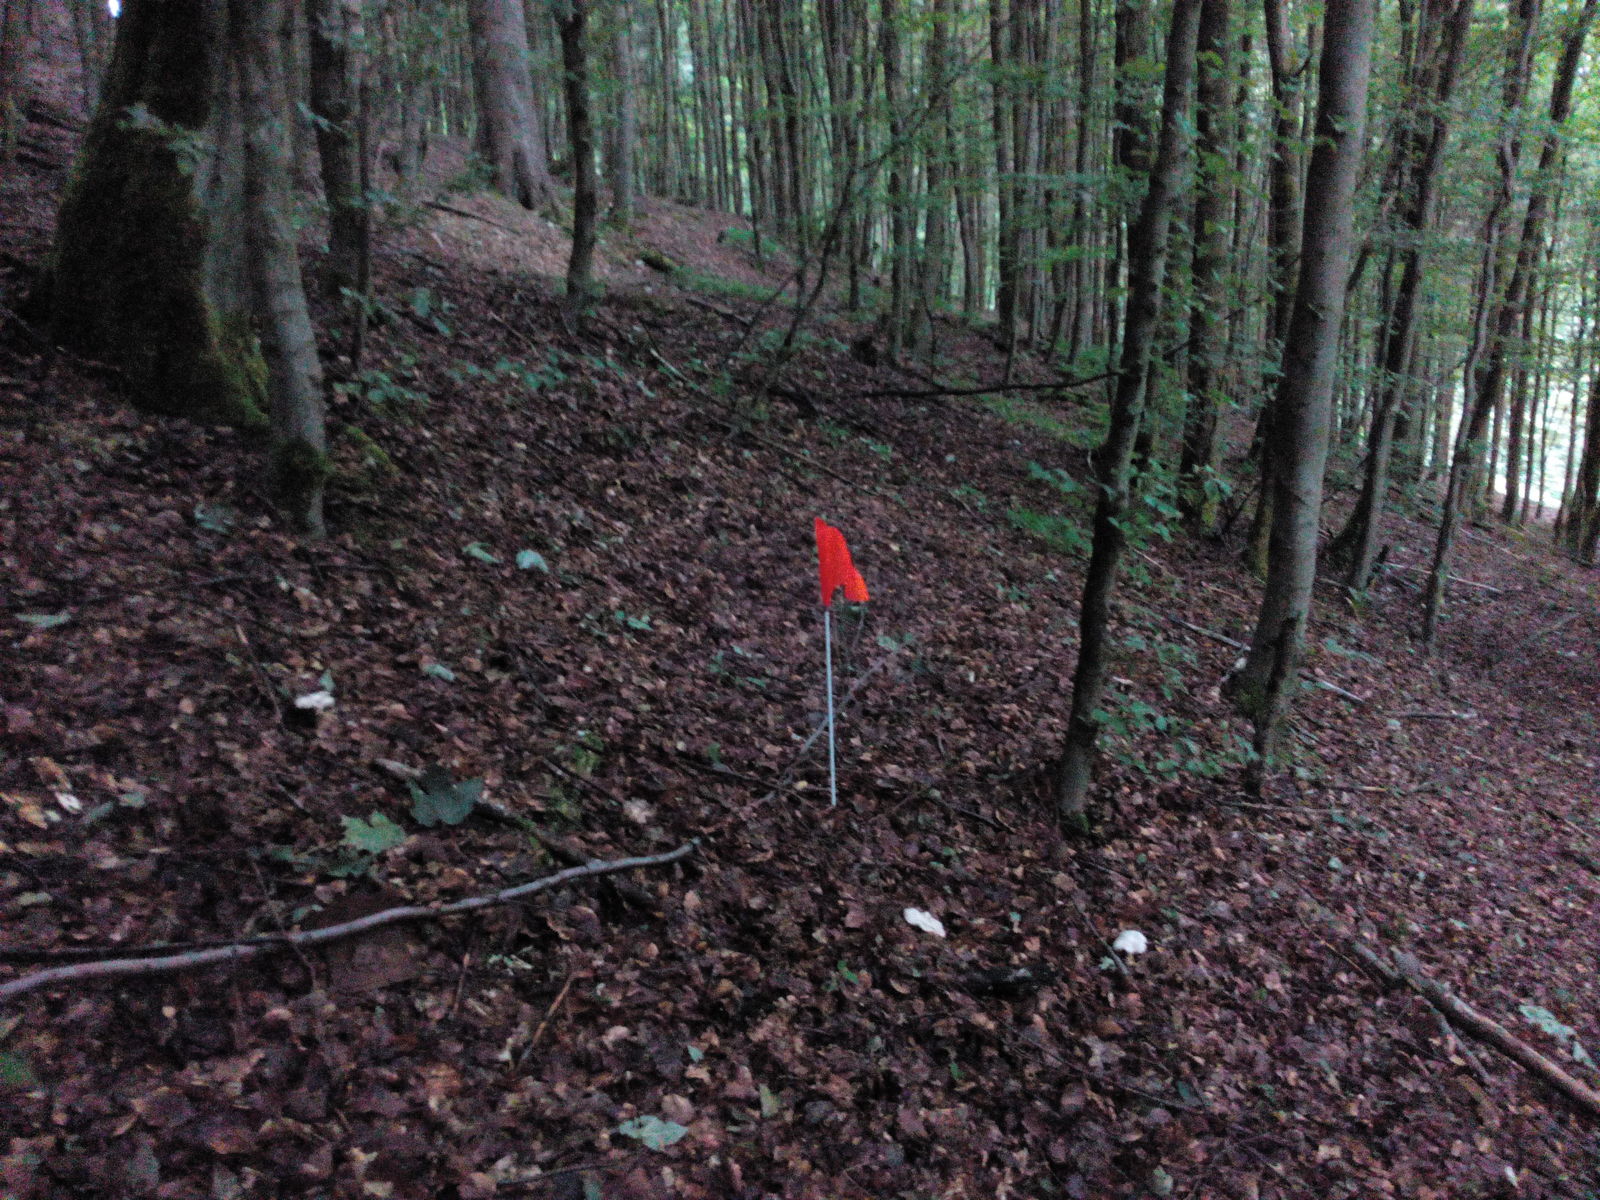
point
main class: Woodland
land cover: Broadleaved woodland
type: beech forest
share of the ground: > 75 %
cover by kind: broadleaved forest trees 100 %
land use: Forestry
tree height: > 5 m
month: June
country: DE
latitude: 50.5588
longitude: 10.8326
